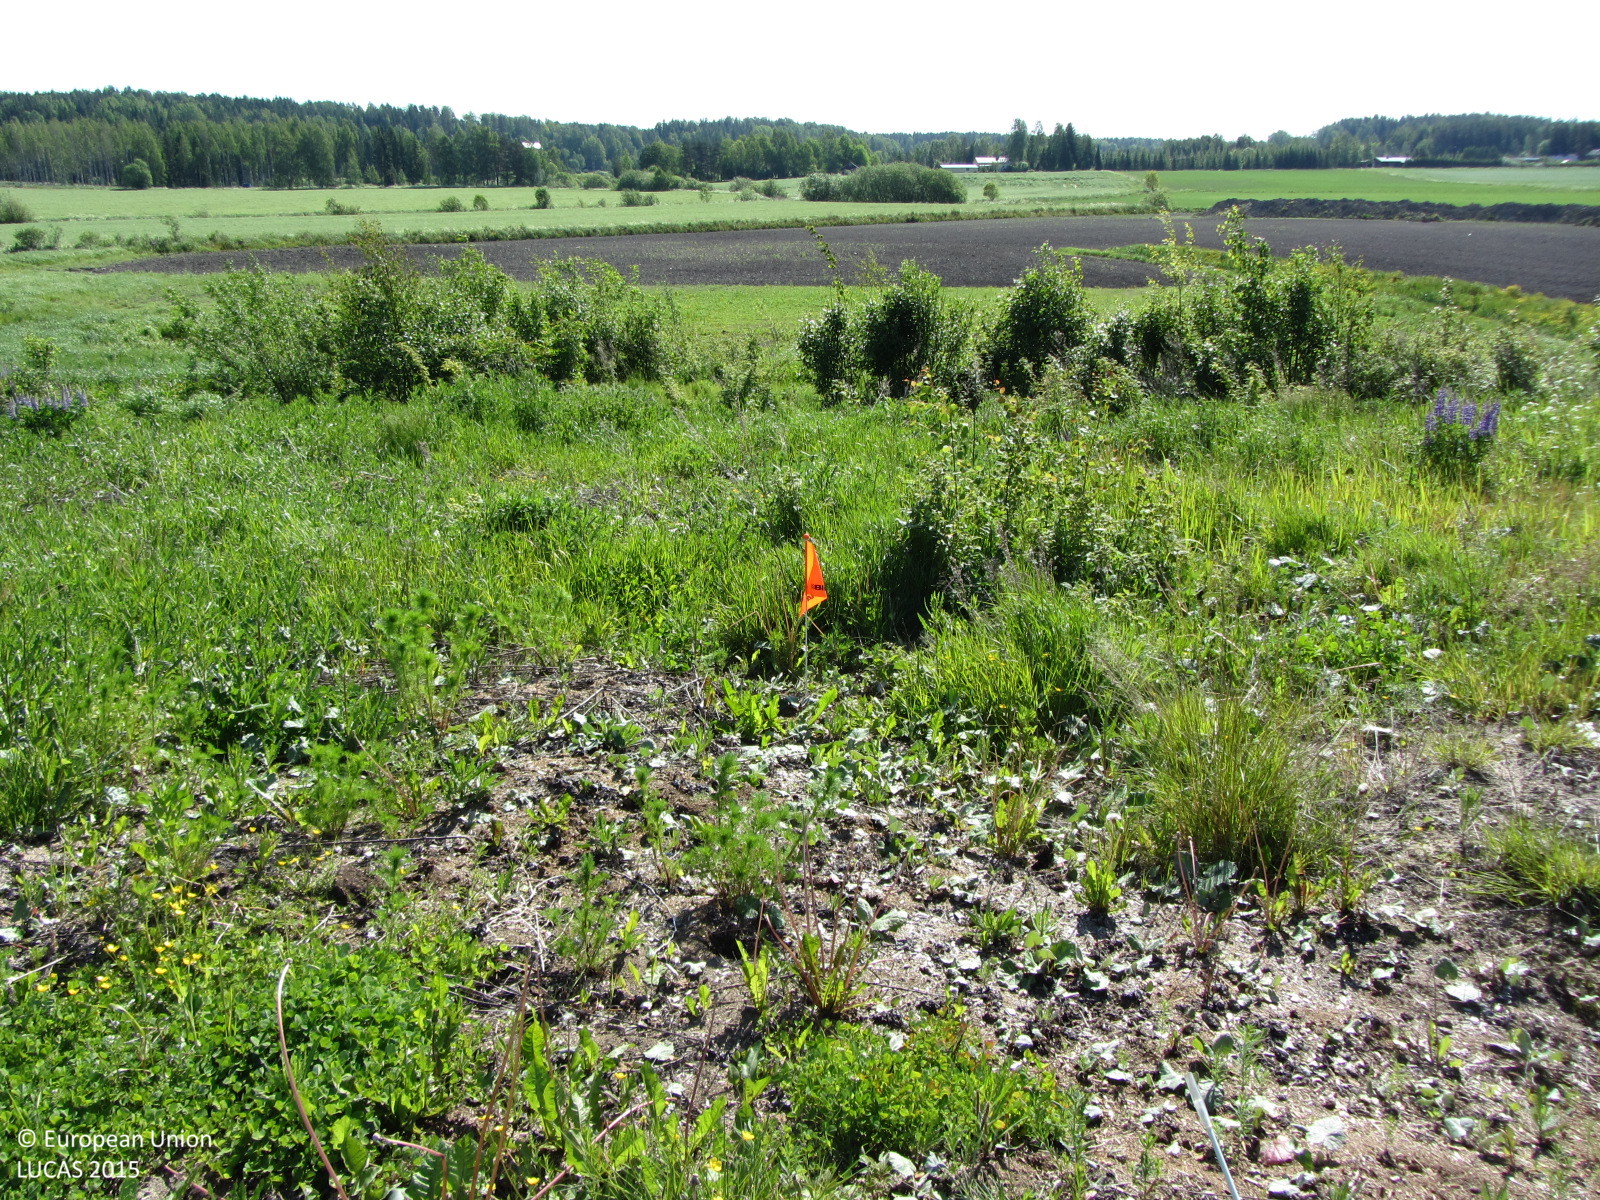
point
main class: Grassland
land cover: Grassland with sparse tree/shrub cover
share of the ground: > 75 %
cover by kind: herbaceous plants 90 %, broadleaved forest trees 5 %, unconsolidated bare surface 5 %
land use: Semi-natural and natural areas not in use
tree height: < 5 m
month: June
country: FI
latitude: 60.3815
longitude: 24.3063
